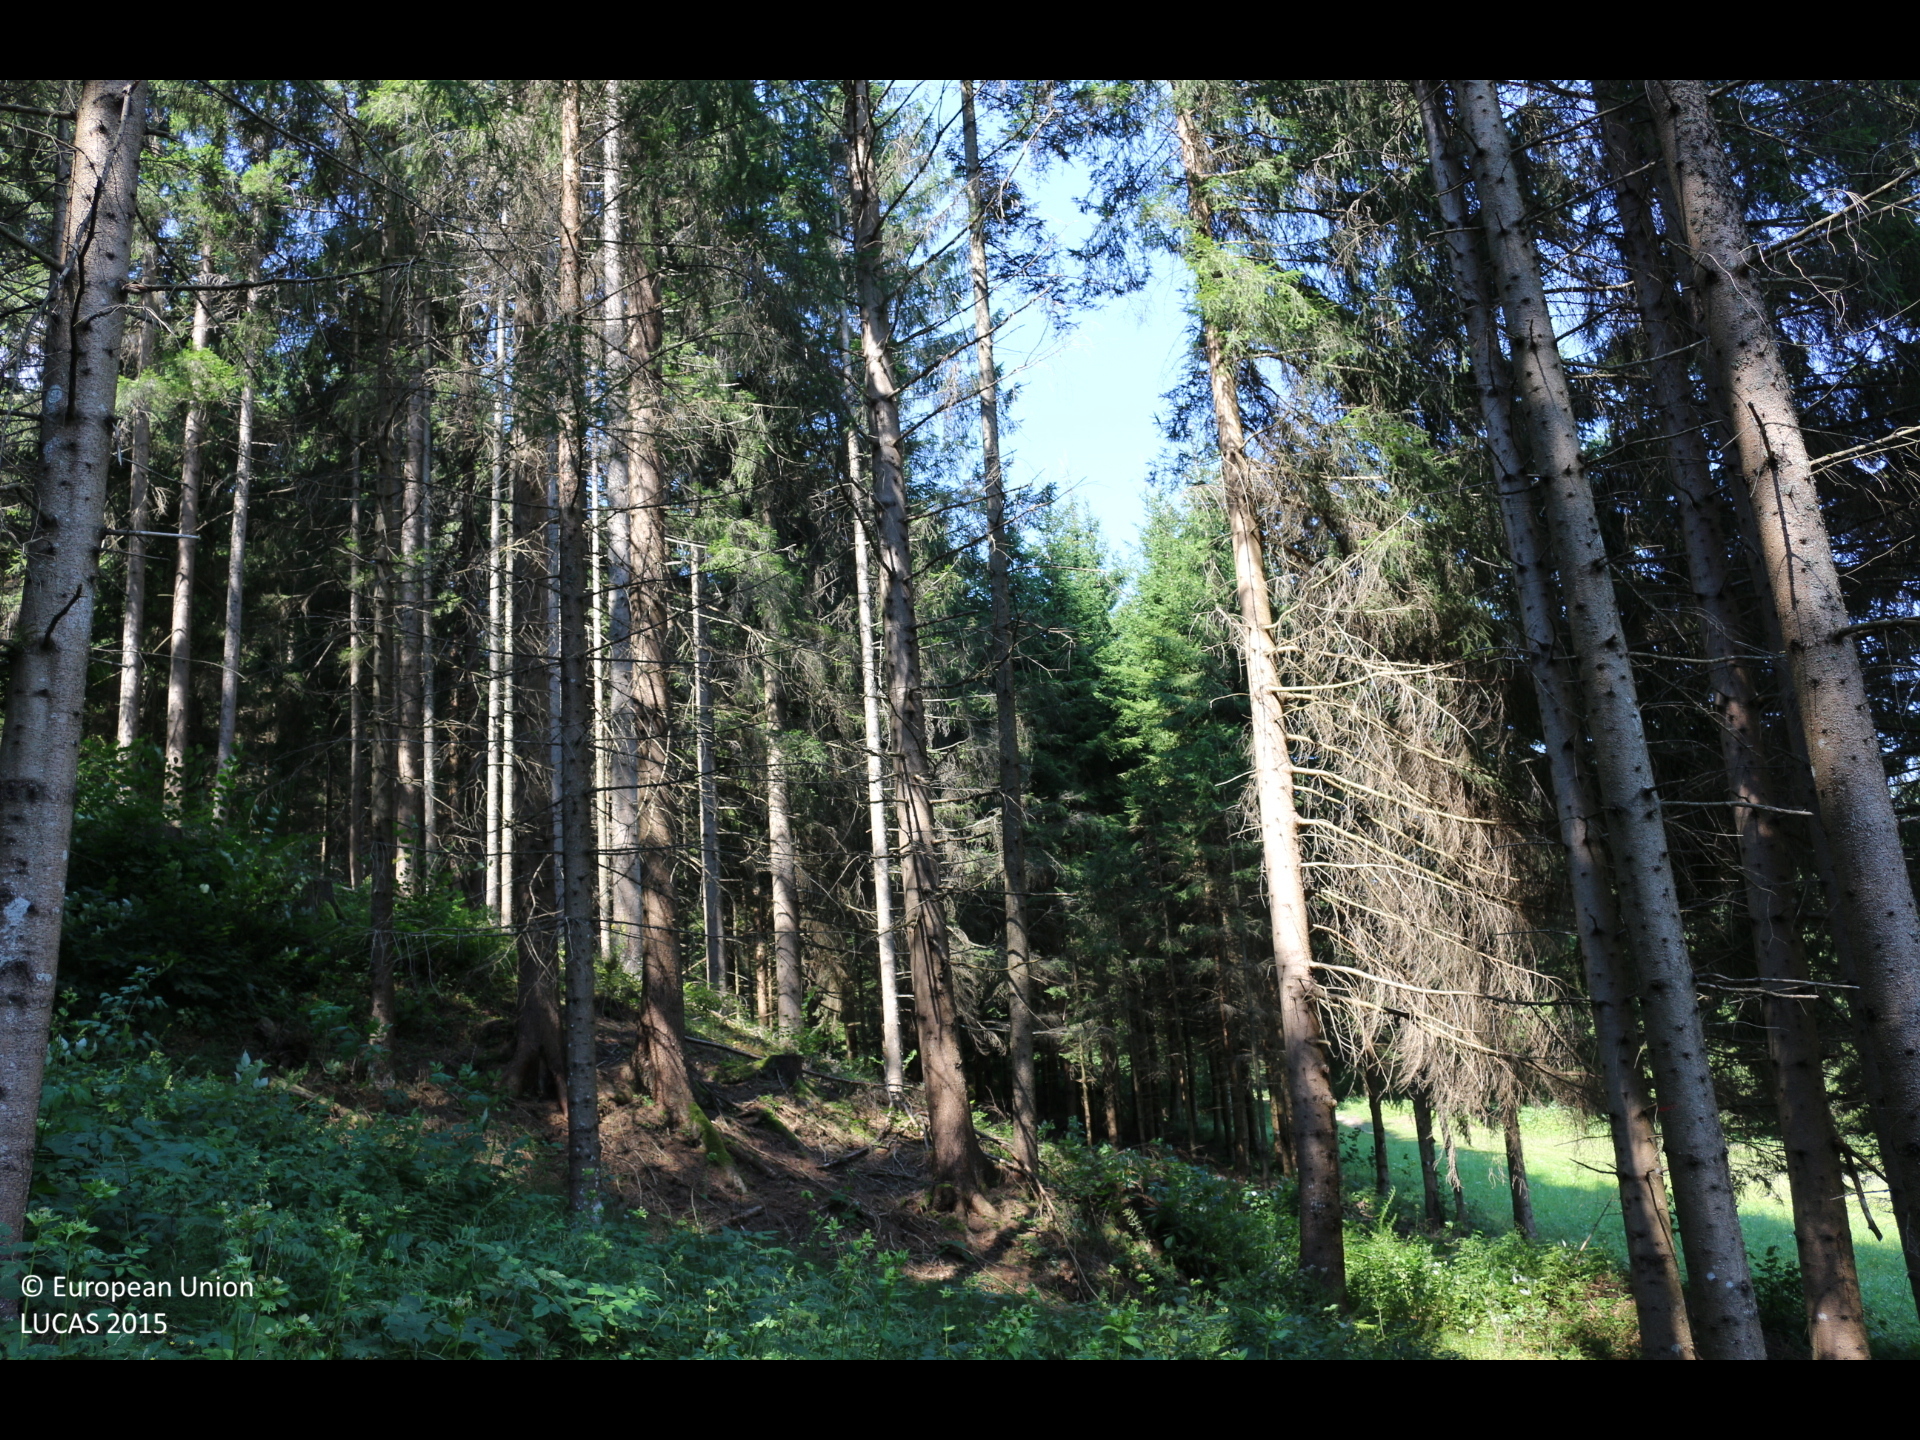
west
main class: Woodland
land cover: Spruce dominated coniferous woodland
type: alpine coniferous forest
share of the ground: > 75 %
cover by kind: coniferous forest trees 85 %, herbaceous plants 10 %, shrubs 5 %
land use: Forestry
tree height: > 5 m
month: August
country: AT
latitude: 46.6607
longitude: 13.3036
